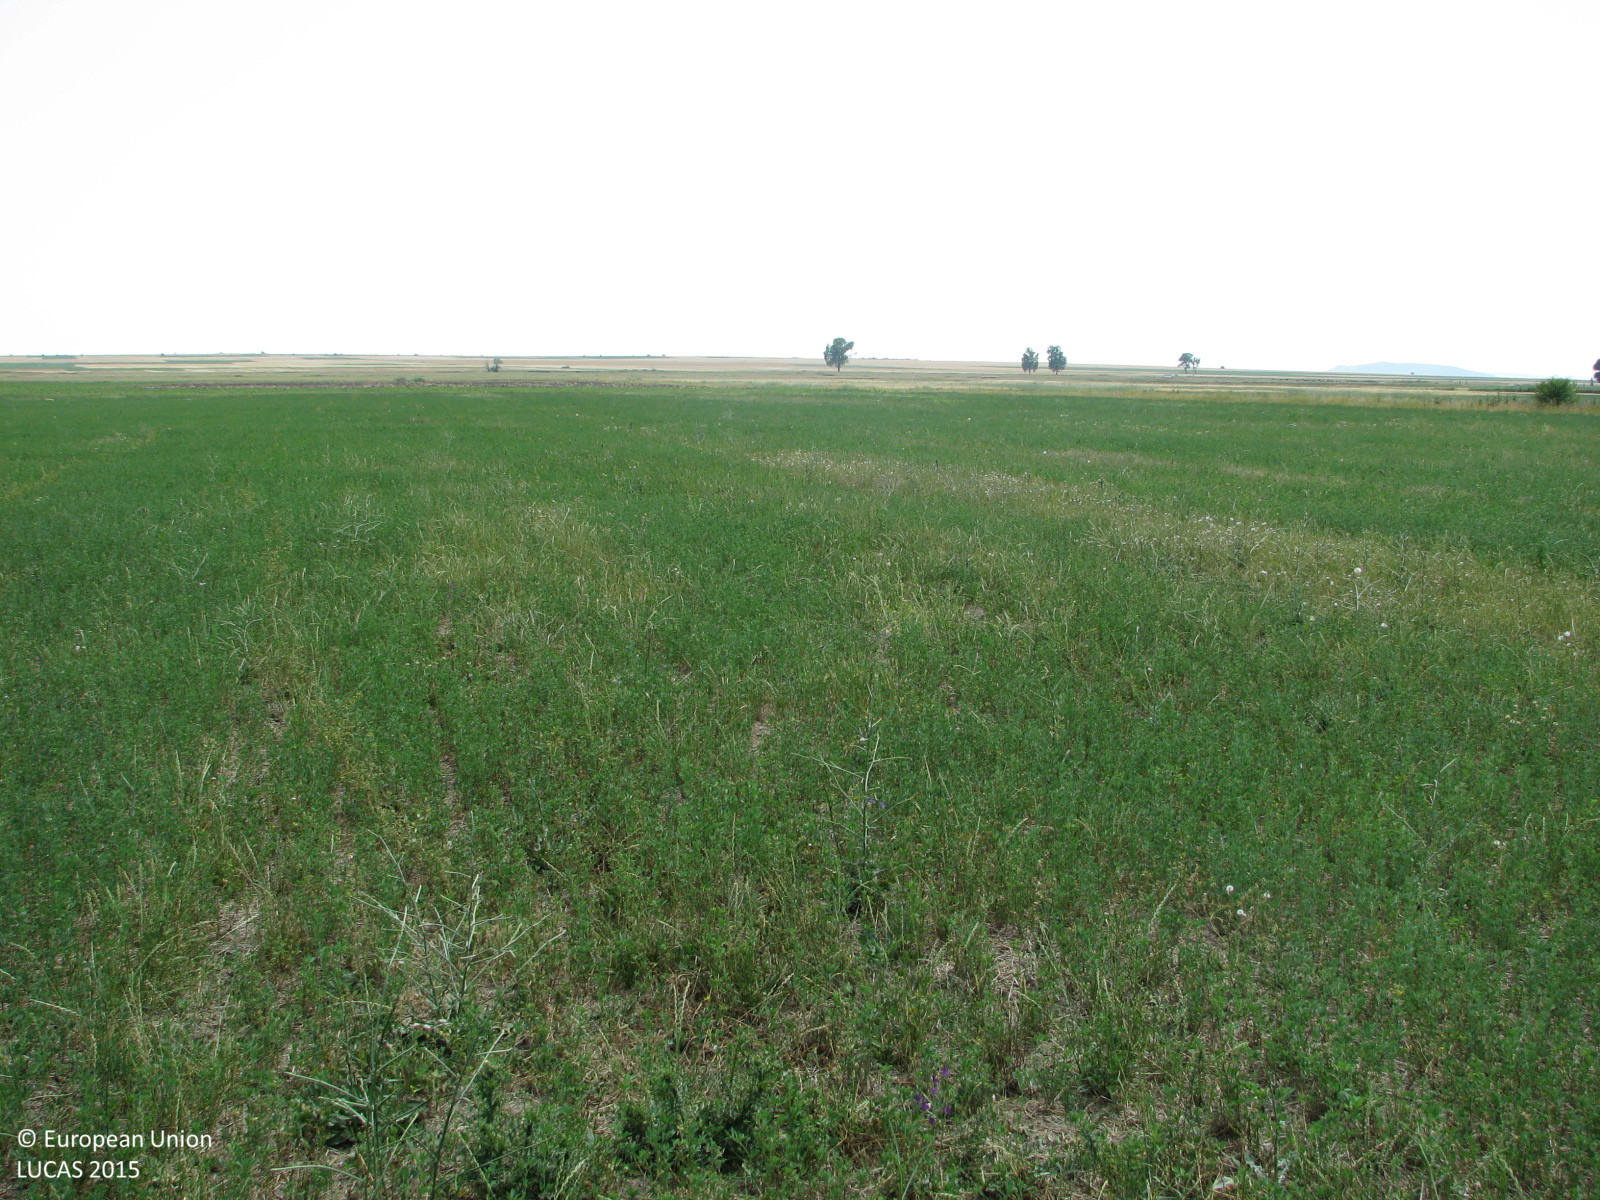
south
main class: Cropland
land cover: Lucerne
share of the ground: > 75 %
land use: Agriculture (excluding fallow land and kitchen gardens)
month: June
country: BG
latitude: 42.6254
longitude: 26.5432
